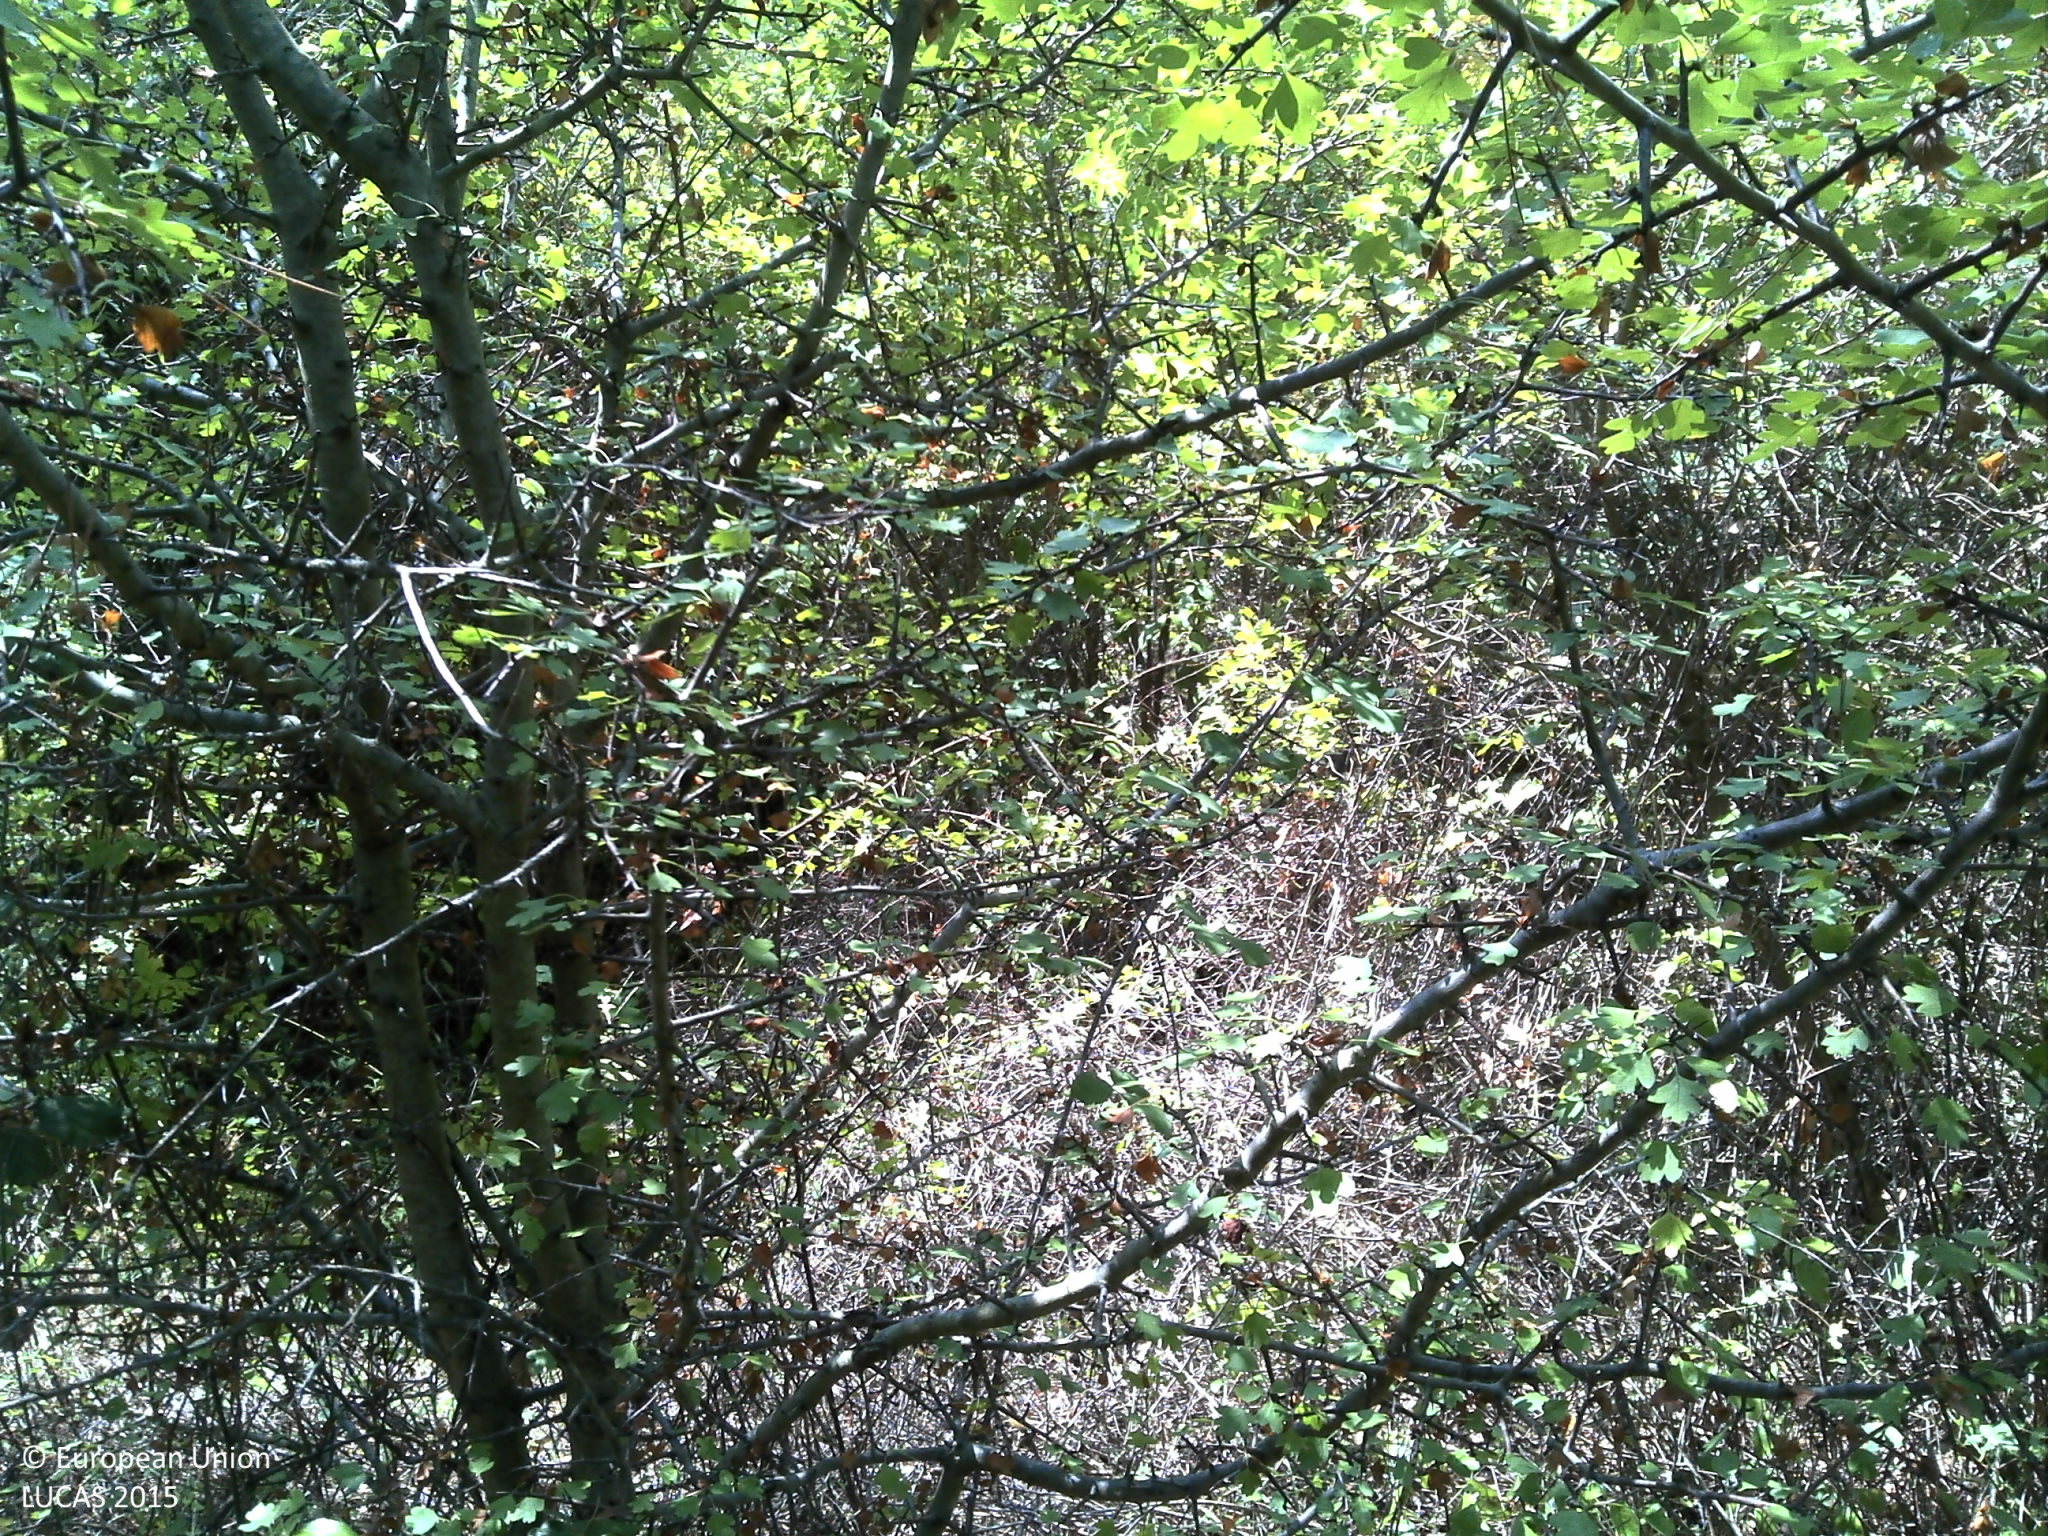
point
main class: Woodland
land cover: Other mixed woodland
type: coniferous forest of the mediterranean region
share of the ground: > 75 %
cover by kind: shrubs 45 %, coniferous forest trees 30 %, broadleaved forest trees 25 %
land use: Semi-natural and natural areas not in use
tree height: > 5 m
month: August
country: HR
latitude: 42.9121
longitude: 16.8360
